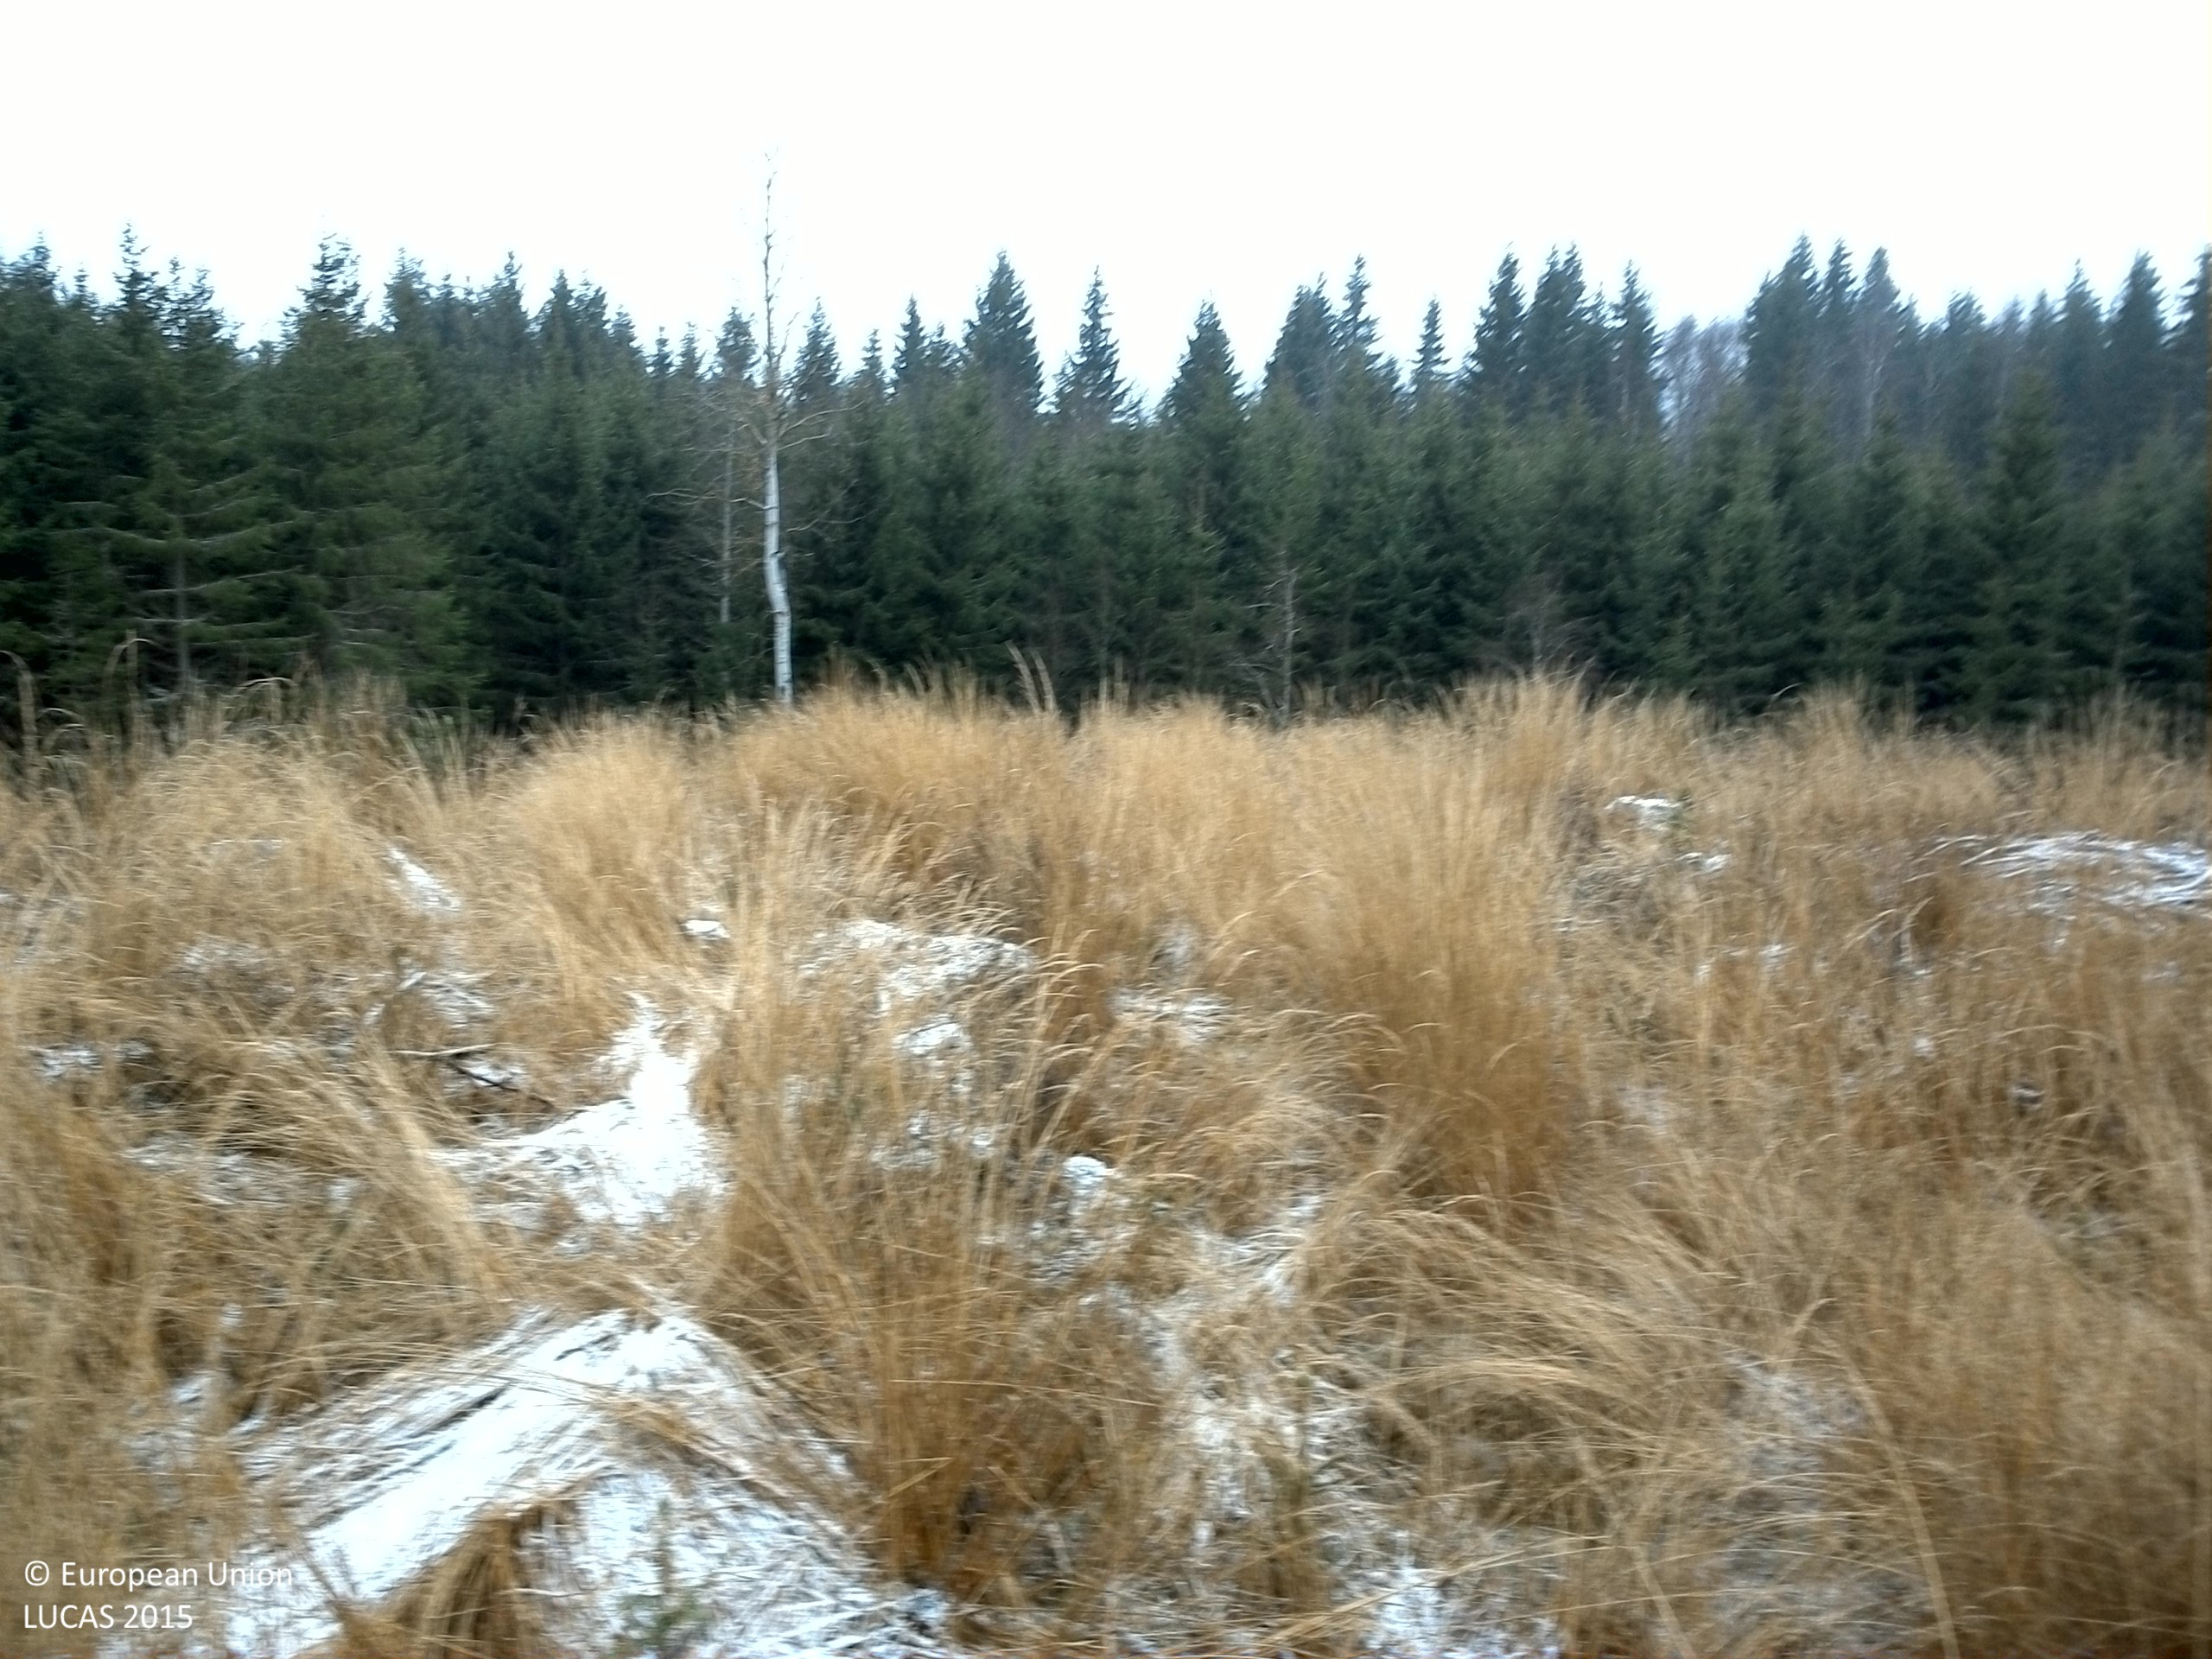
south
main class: Grassland
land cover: Grassland with sparse tree/shrub cover
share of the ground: > 75 %
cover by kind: herbaceous plants 90 %, broadleaved forest trees 5 %, consolidated bare surface 5 %
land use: Forestry
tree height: > 5 m
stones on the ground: < 10 %
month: November
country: SE
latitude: 60.2455
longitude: 16.5469
